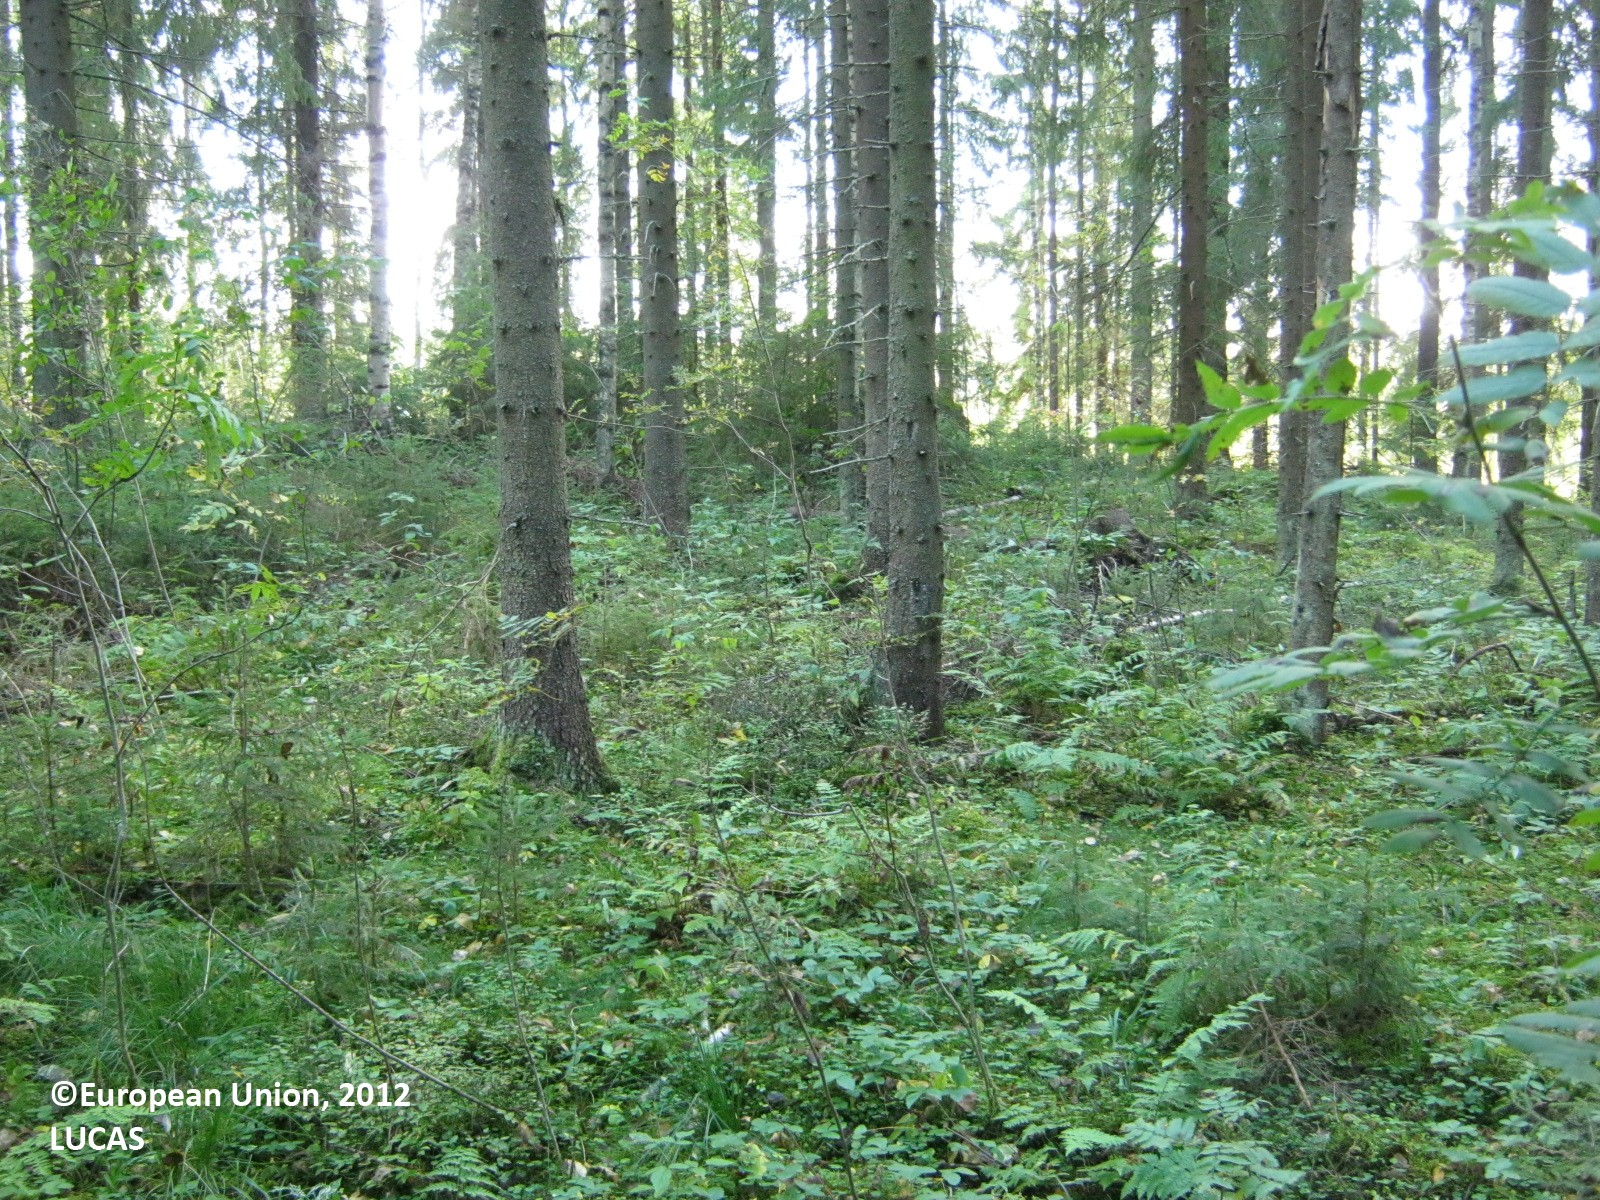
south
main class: Woodland
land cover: Other coniferous woodland
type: boreal forest
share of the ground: 50 - 75 %
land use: Forestry
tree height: > 5 m
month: September
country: FI
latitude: 60.9234
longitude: 27.8095
